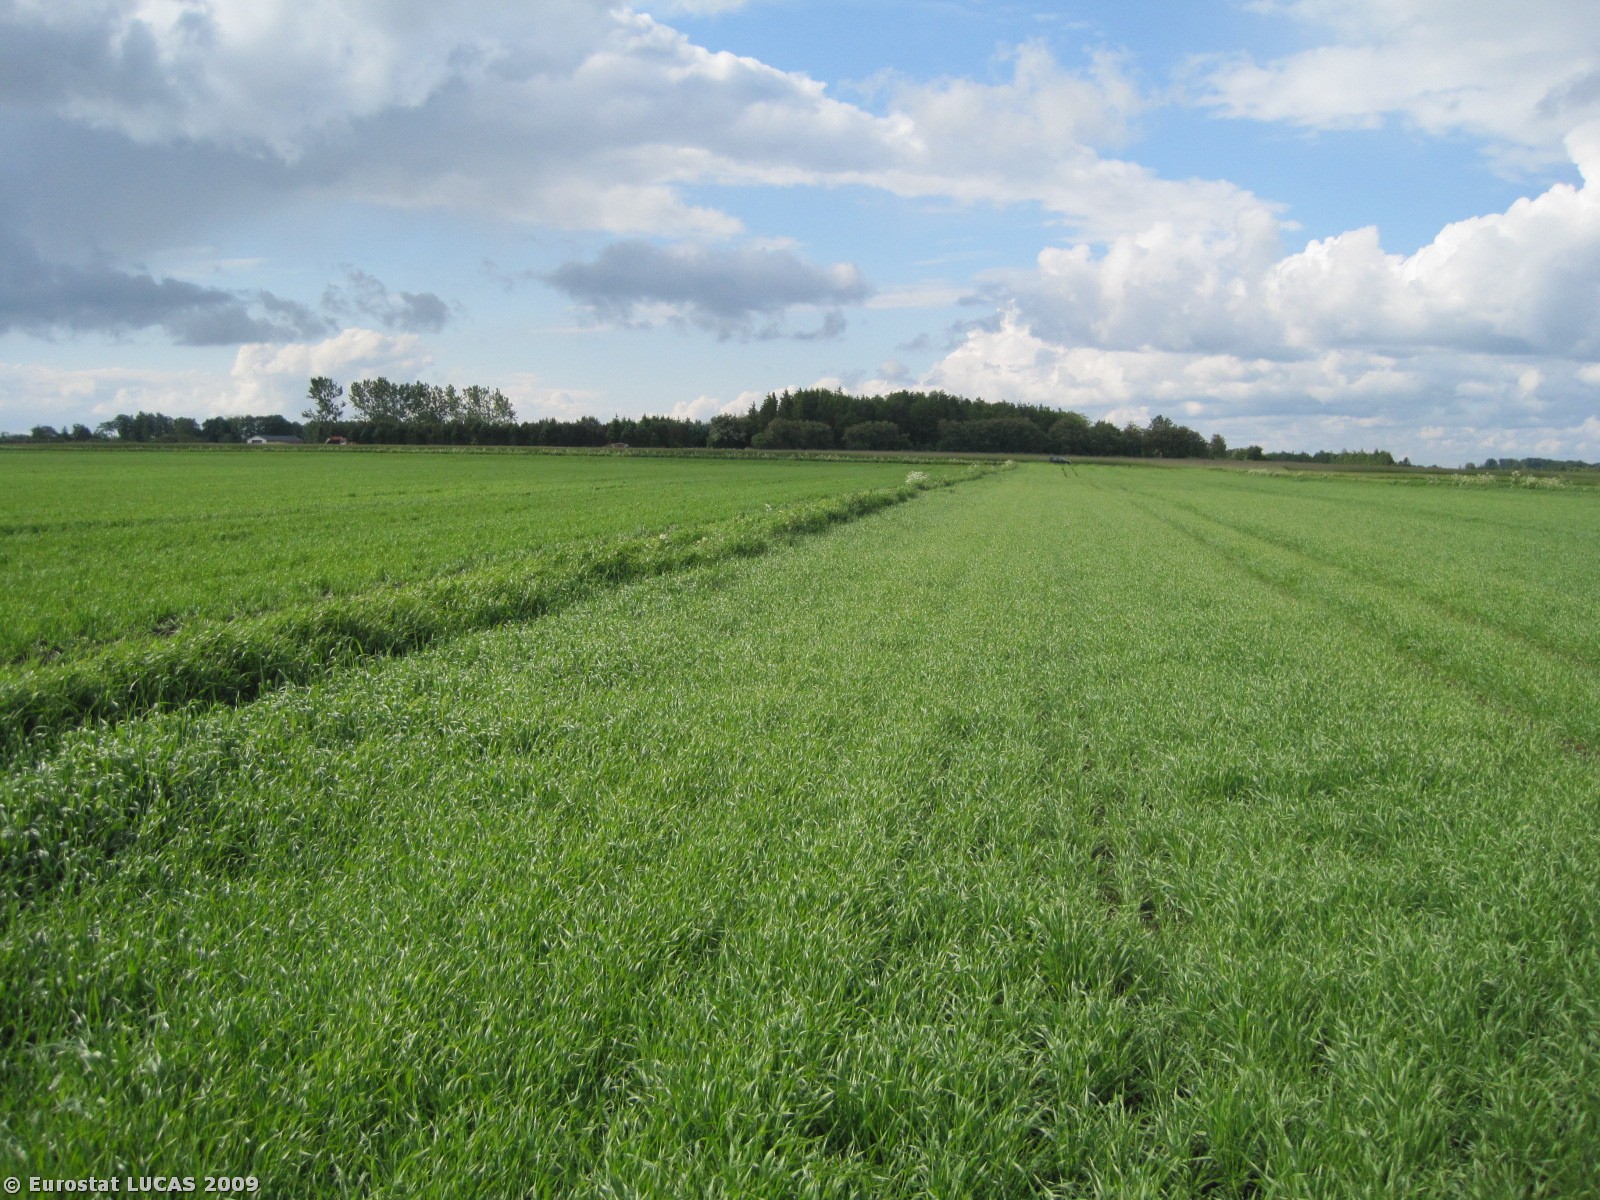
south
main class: Cropland
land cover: Barley
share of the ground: > 75 %
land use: Agriculture (excluding fallow land and kitchen gardens)
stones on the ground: < 10 %
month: June
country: DK
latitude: 57.1044
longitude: 10.2143
